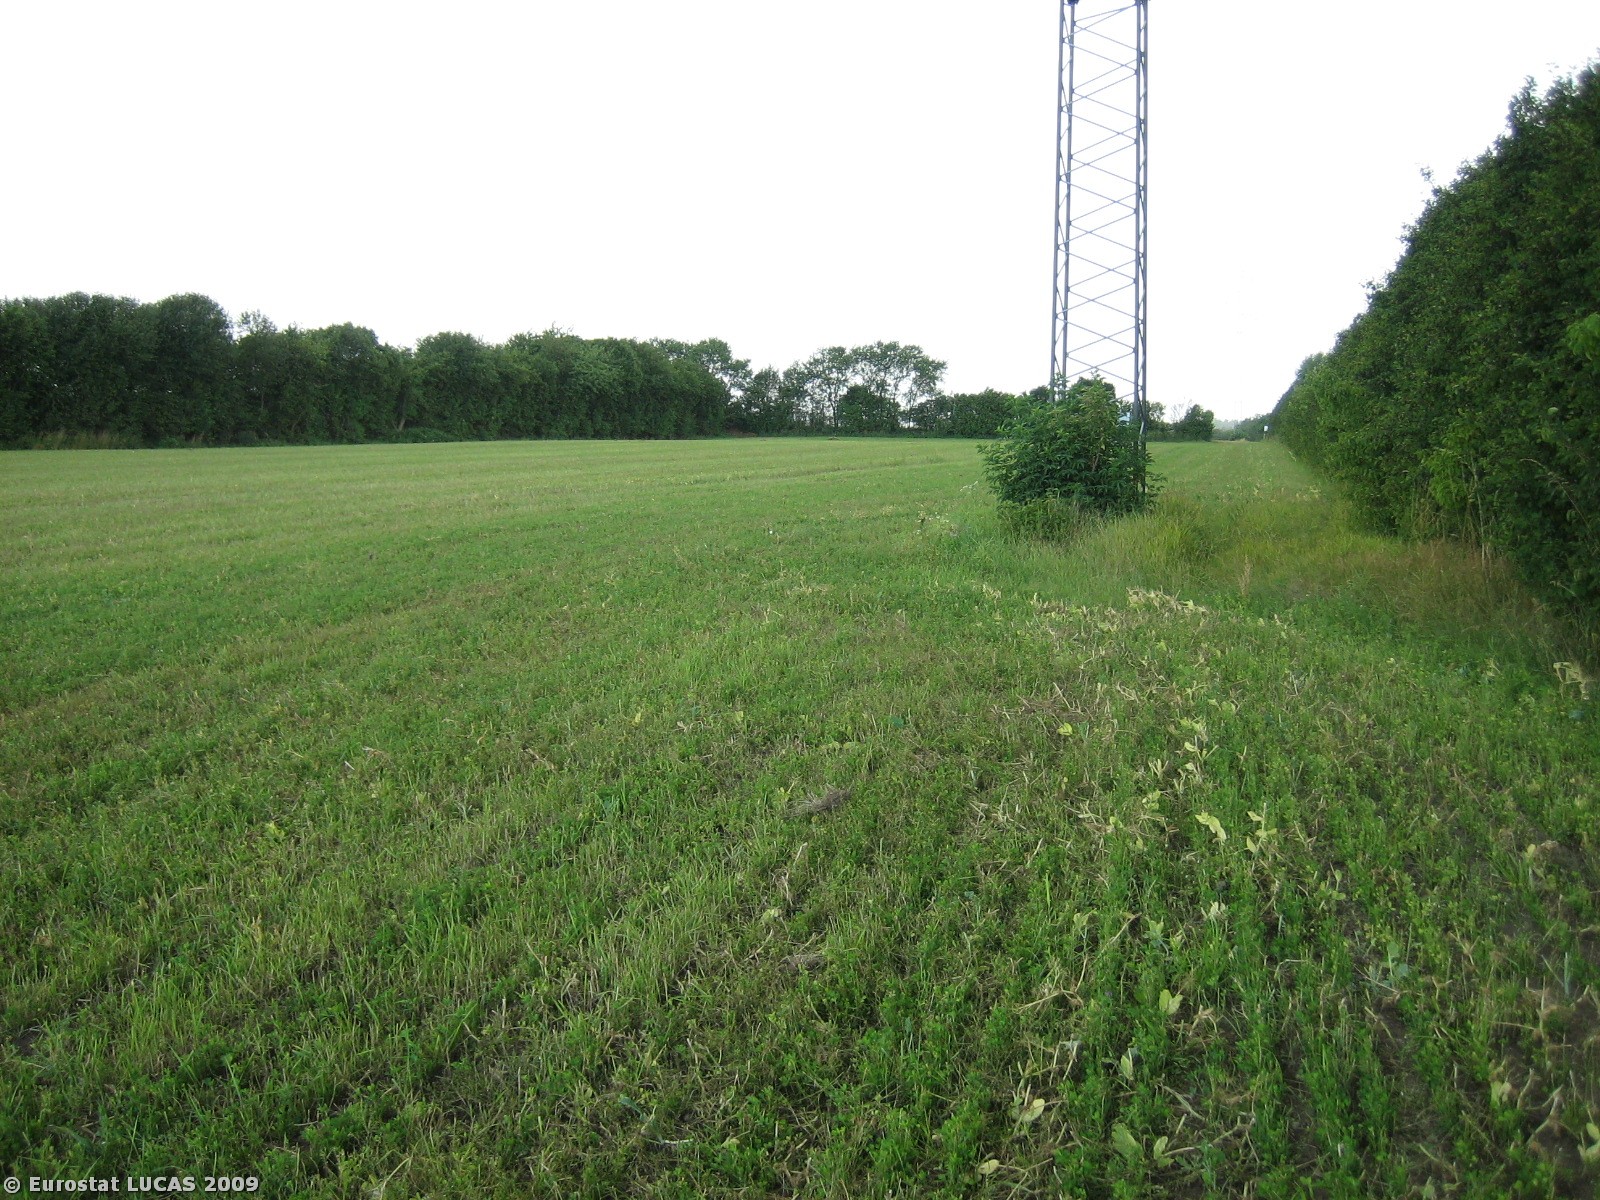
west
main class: Cropland
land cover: Dry pulses
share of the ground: 10 - 25 %
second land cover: Clovers
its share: 50 - 75 %
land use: Agriculture (excluding fallow land and kitchen gardens)
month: July
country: DK
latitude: 55.5403
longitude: 9.6992
